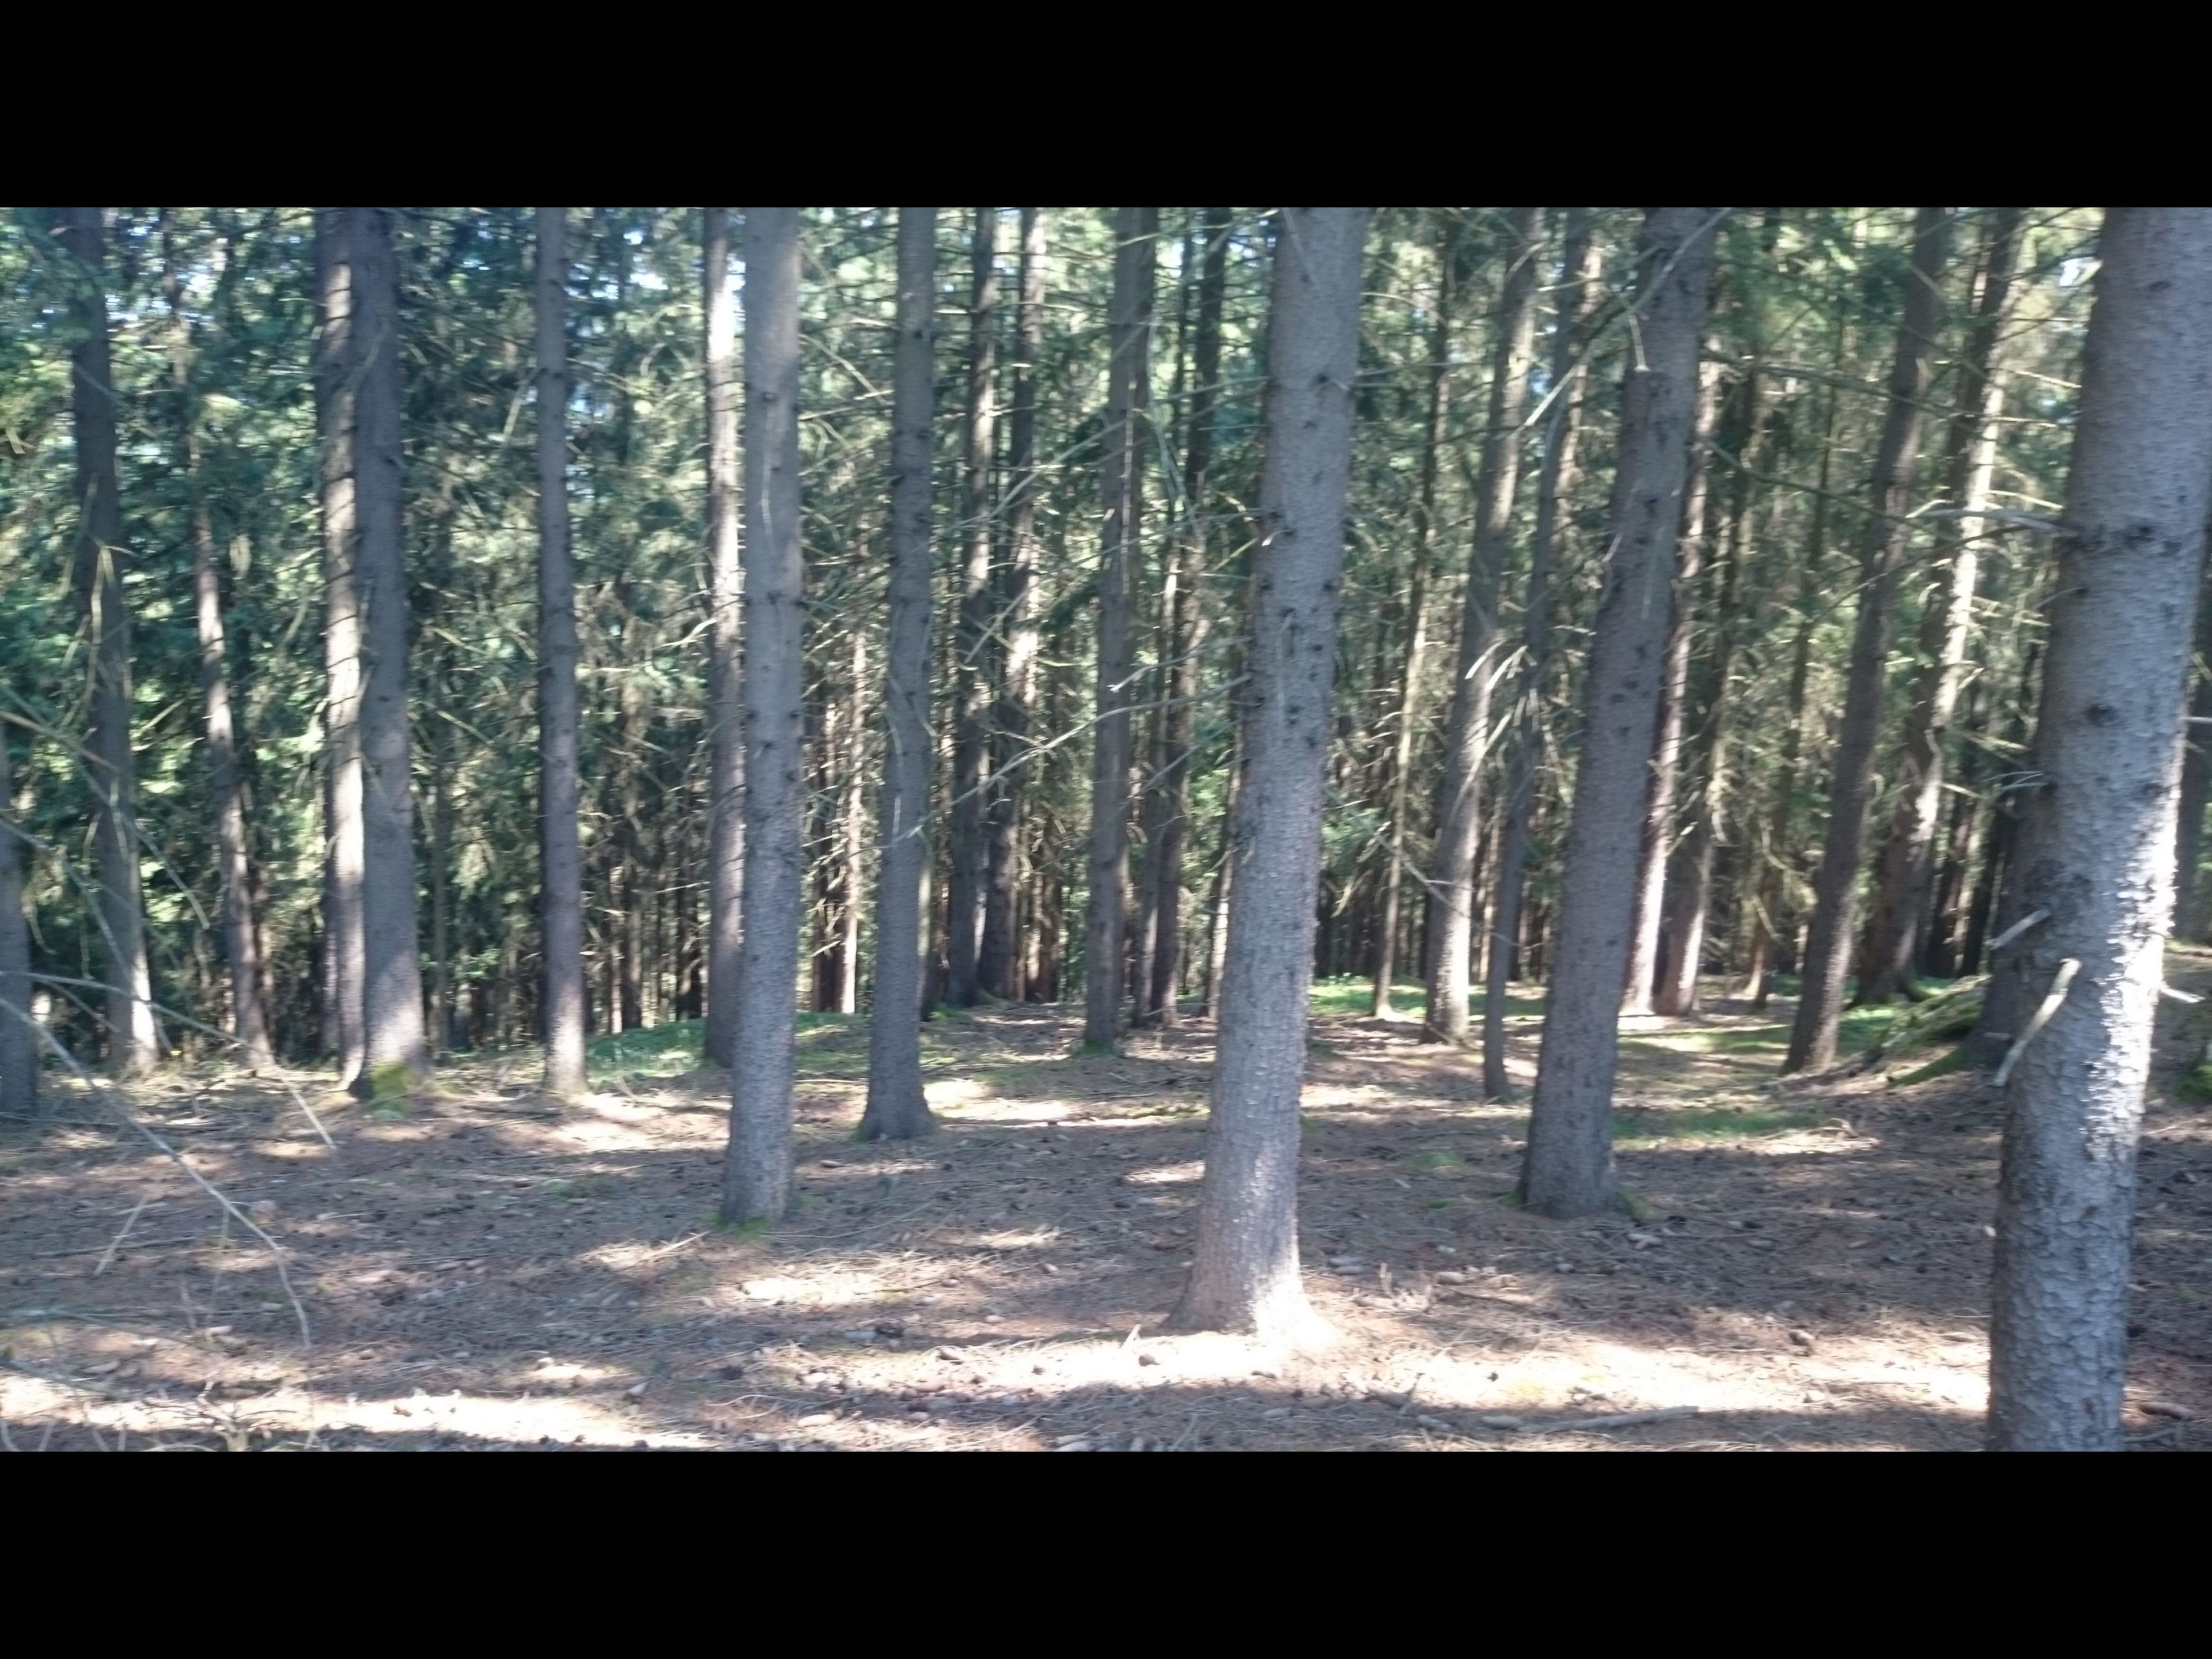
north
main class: Woodland
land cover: Spruce dominated coniferous woodland
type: hemiboreal forest and nemoral coniferous forest and mixed broadleaved-coniferous forest
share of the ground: > 75 %
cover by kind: coniferous forest trees 75 %, unconsolidated bare surface 20 %, shrubs 5 %
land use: Forestry
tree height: > 5 m
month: June
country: AT
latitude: 48.4504
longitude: 14.6384
